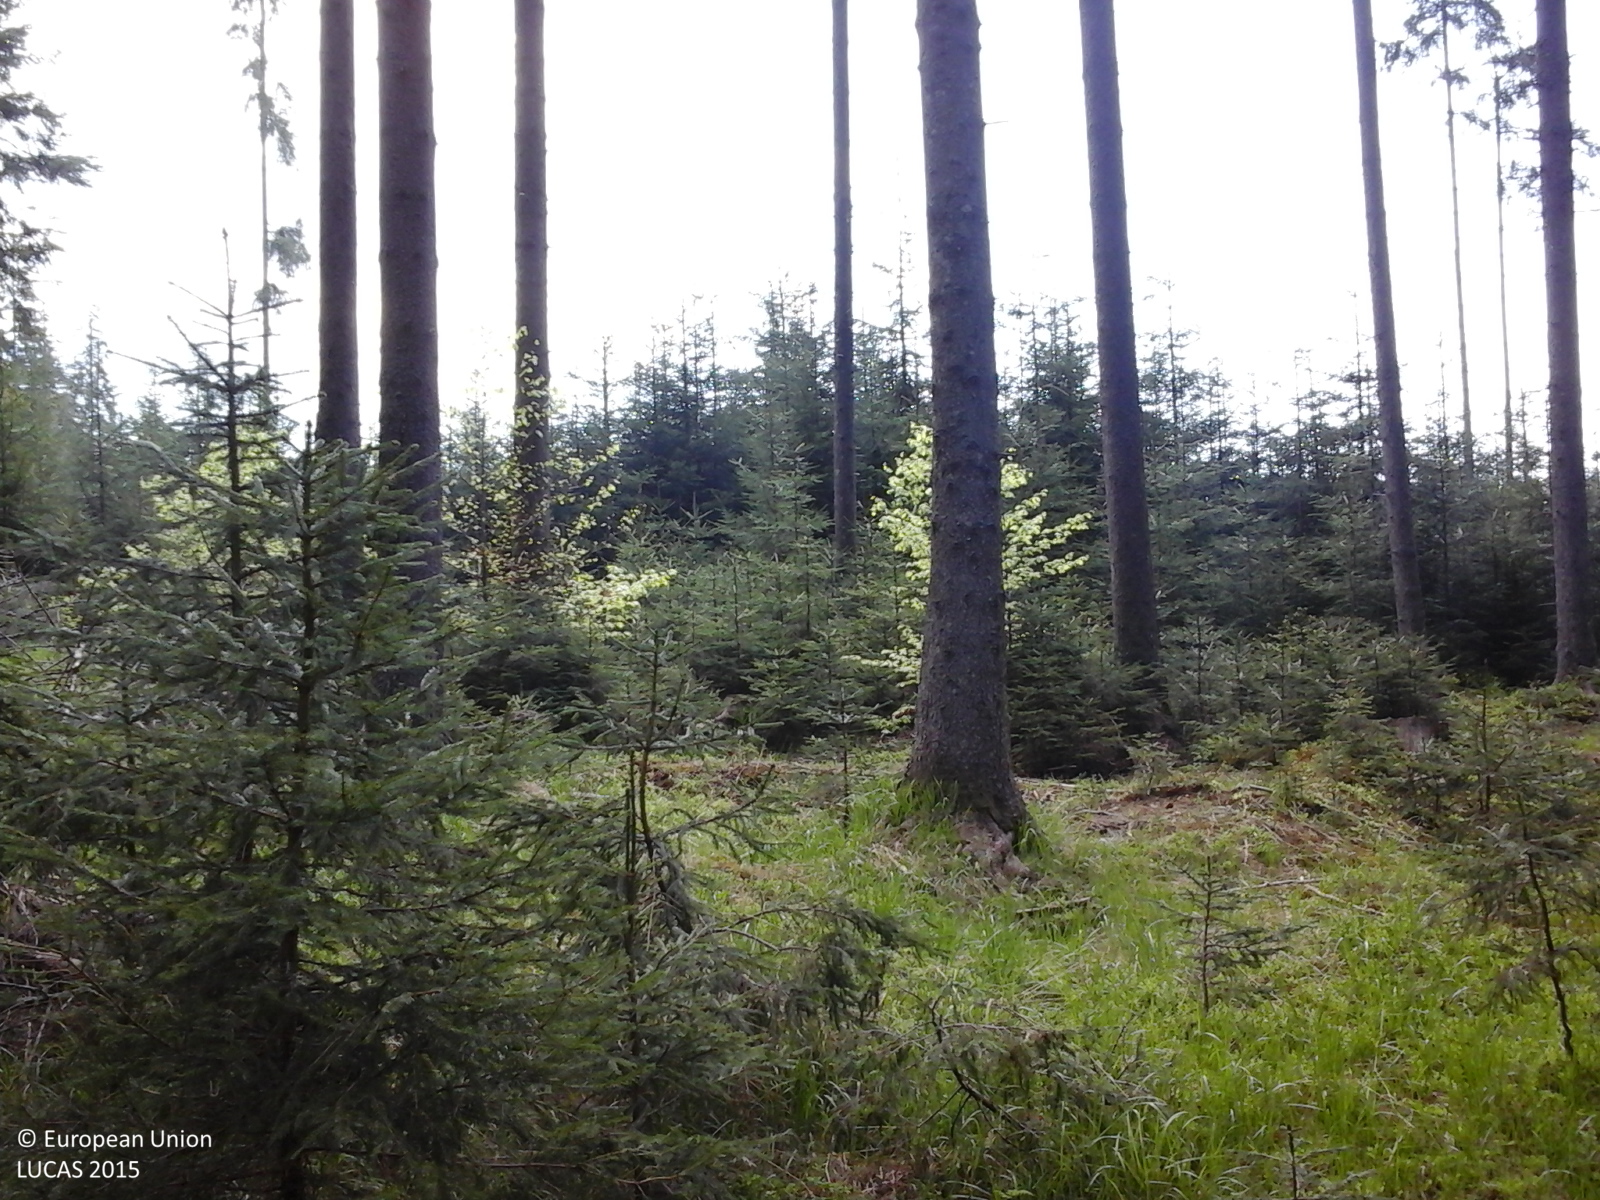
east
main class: Woodland
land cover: Spruce dominated coniferous woodland
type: alpine coniferous forest
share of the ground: > 75 %
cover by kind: coniferous forest trees 90 %, herbaceous plants 10 %
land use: Forestry
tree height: > 5 m
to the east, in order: Spruce dominated coniferous woodland; Tracks; Spruce dominated coniferous woodland
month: May
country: RO
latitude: 45.6703
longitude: 26.2297
